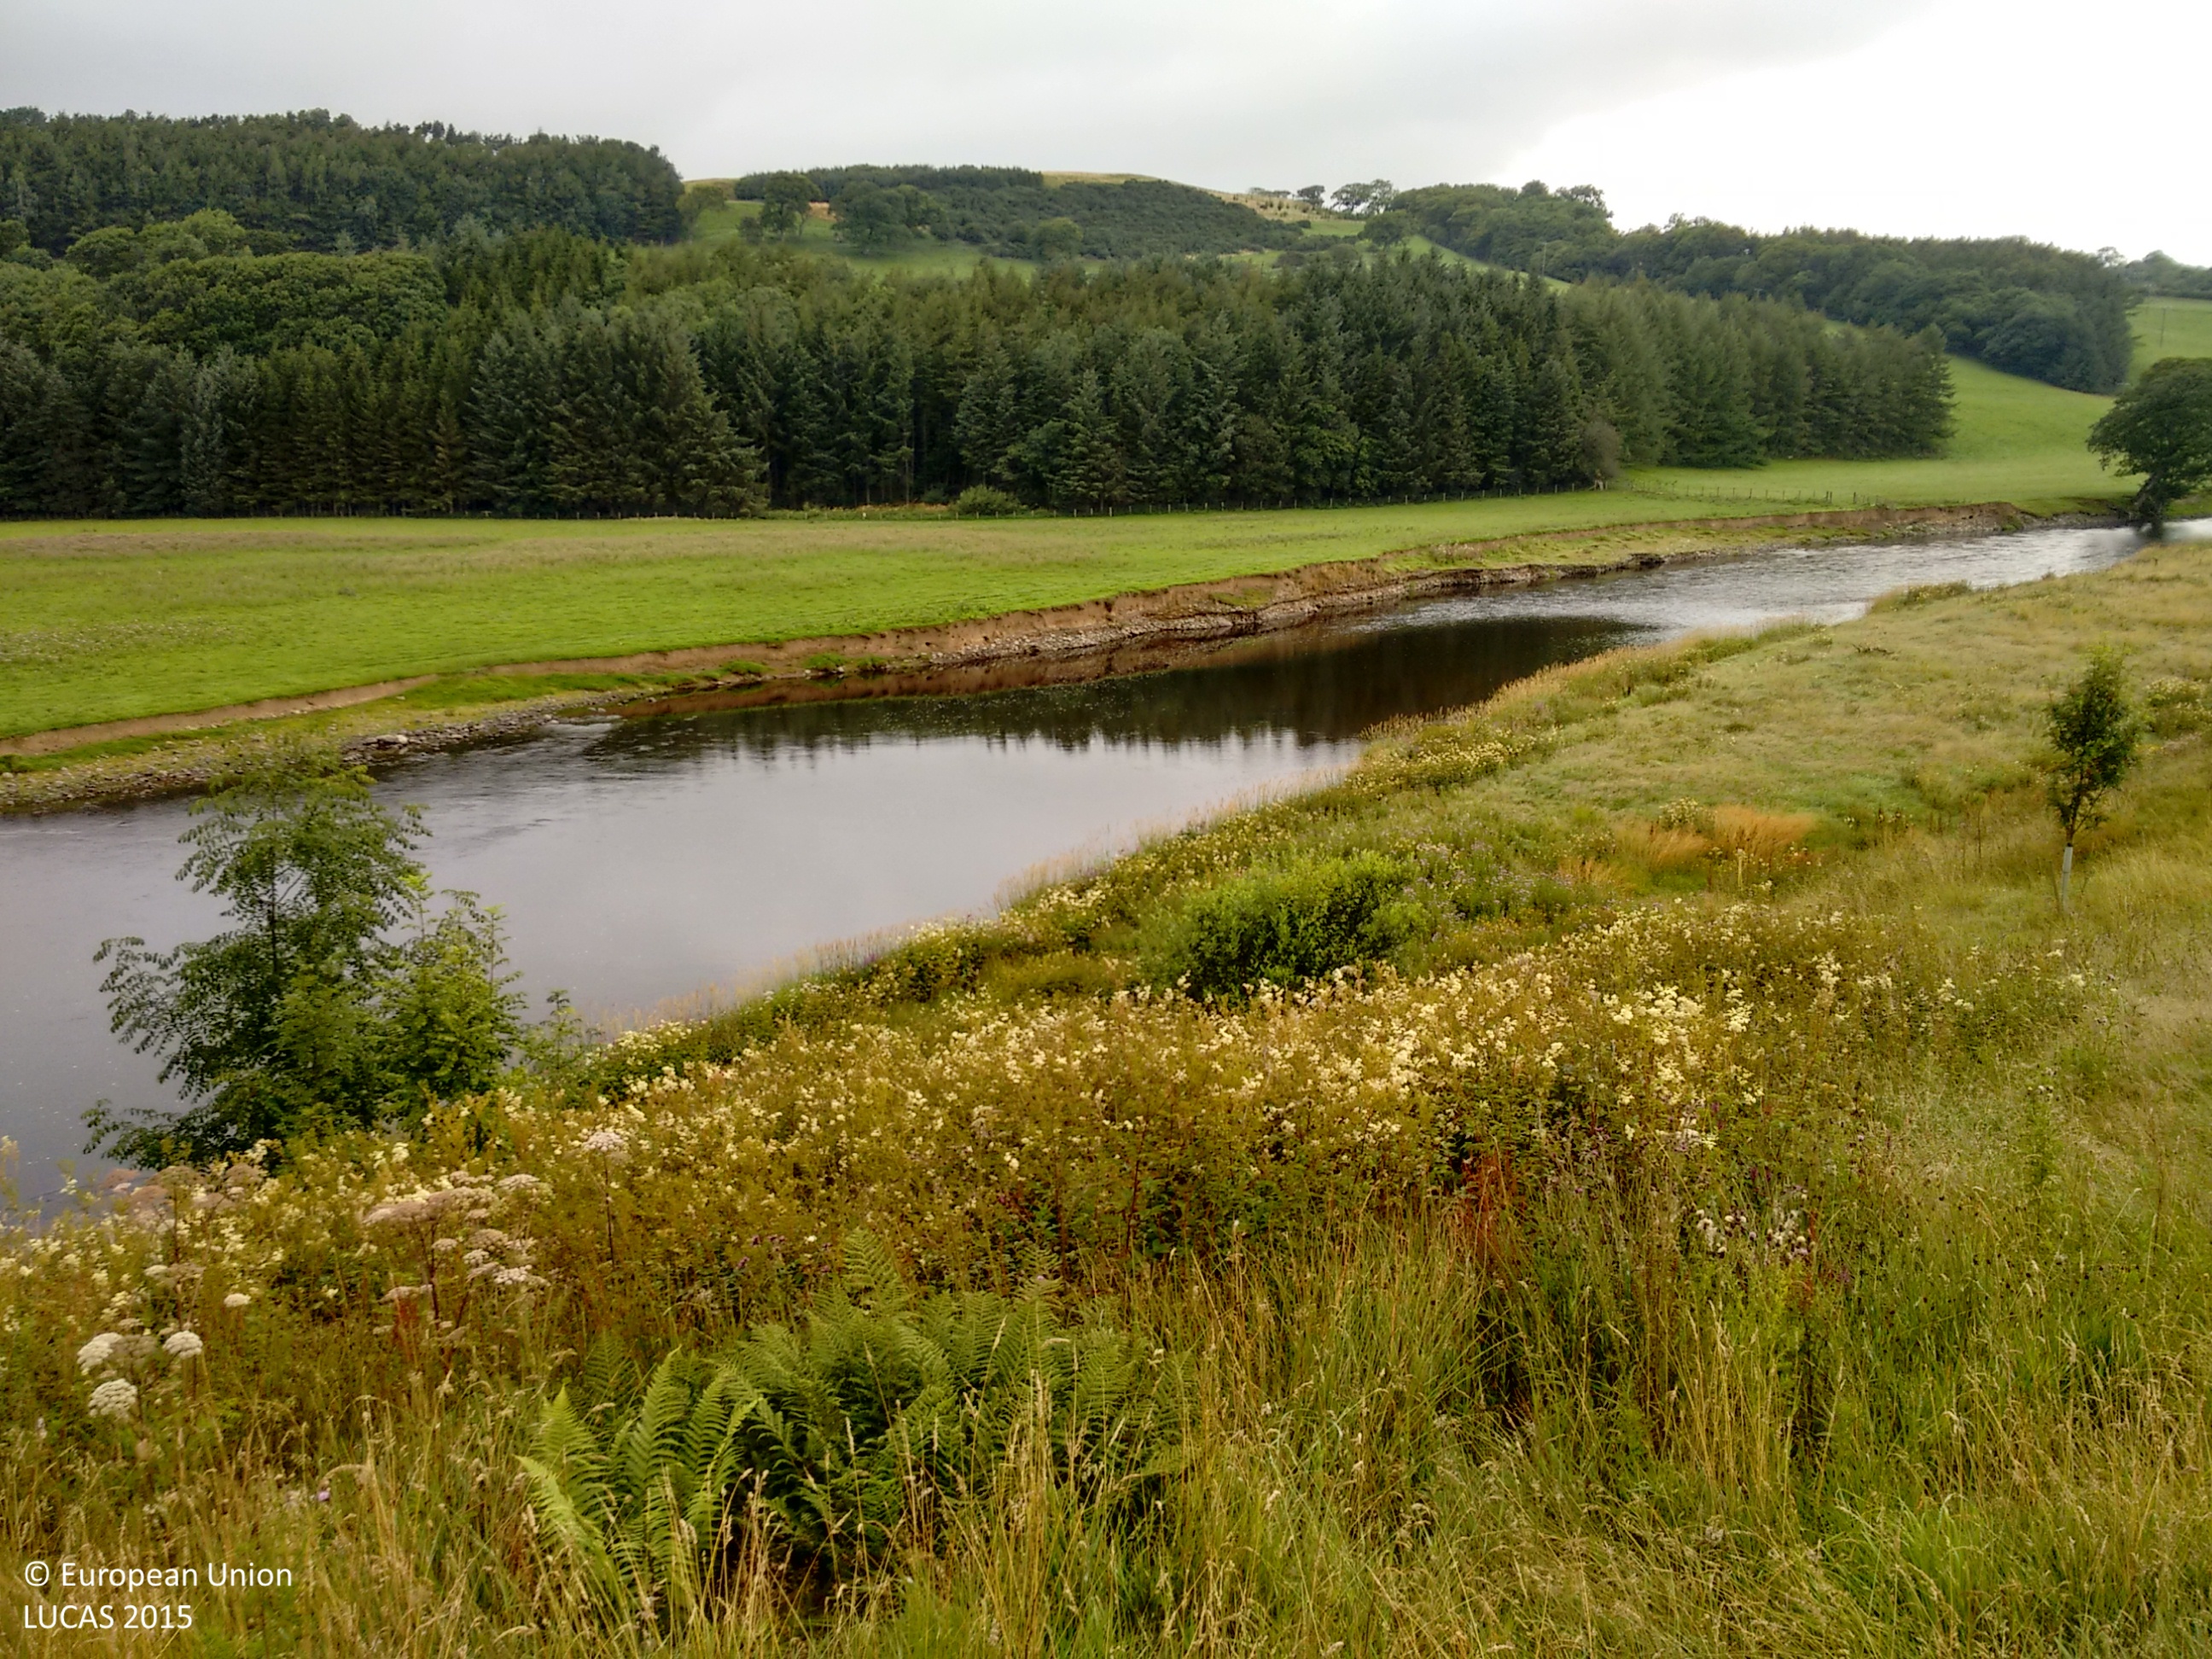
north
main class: Grassland
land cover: Grassland with sparse tree/shrub cover
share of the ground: > 75 %
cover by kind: herbaceous plants 95 %, broadleaved forest trees 5 %
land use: Semi-natural and natural areas not in use
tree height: > 5 m
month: August
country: GB
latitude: 54.6841
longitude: -3.3405
